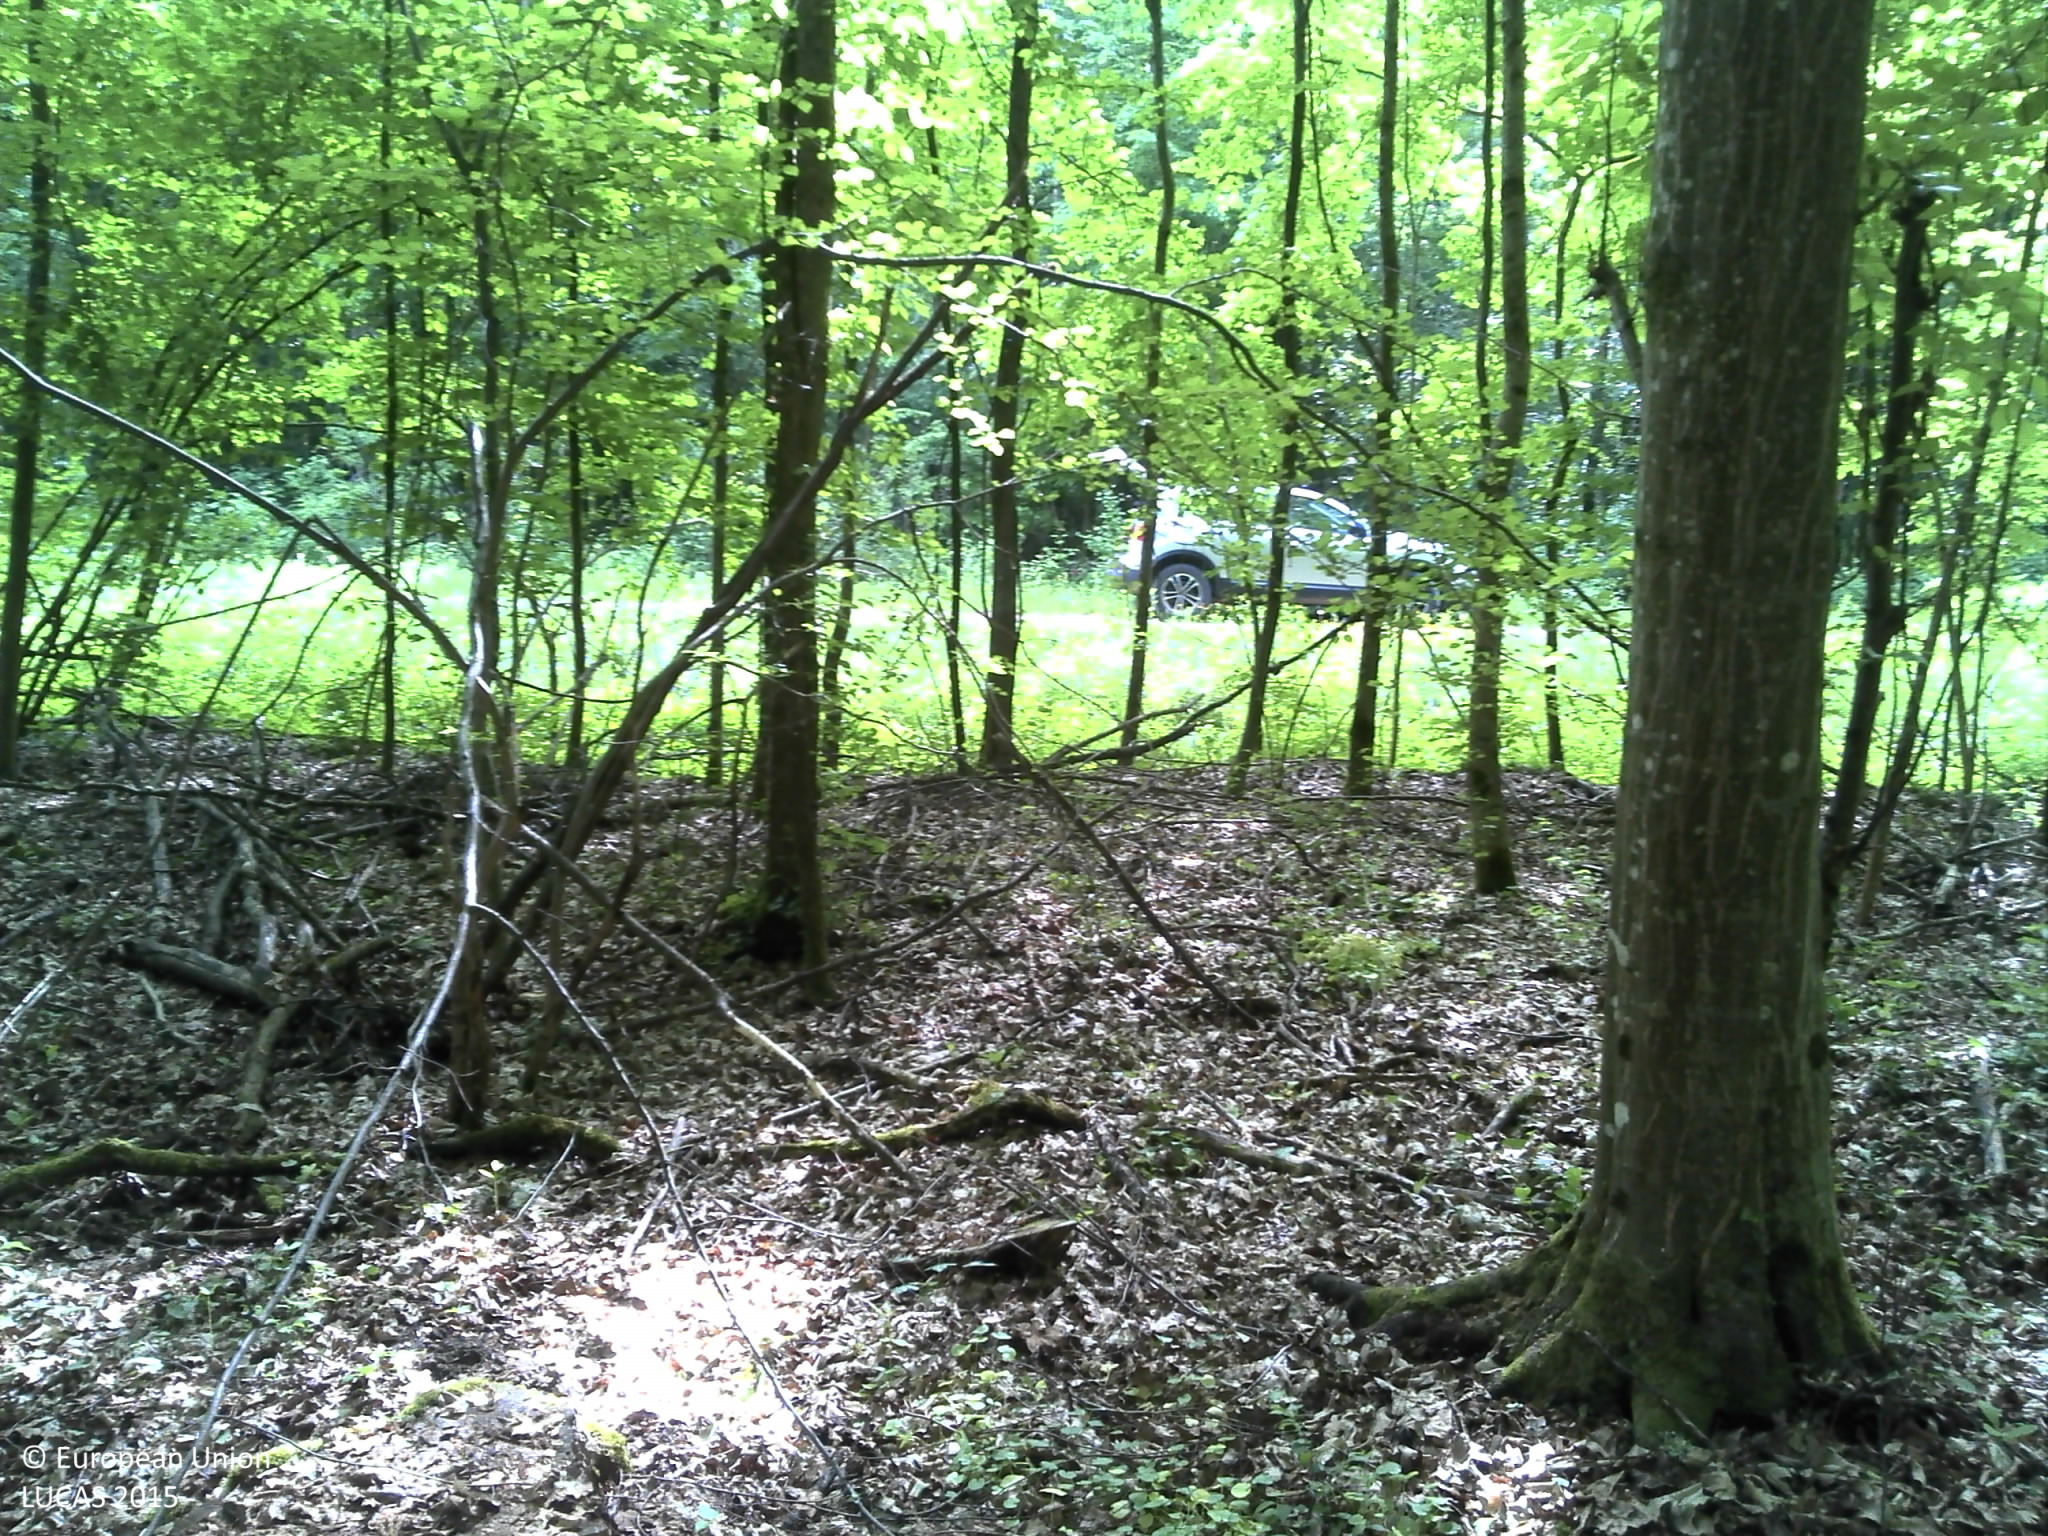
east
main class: Woodland
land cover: Broadleaved woodland
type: mesophytic deciduous forest
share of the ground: > 75 %
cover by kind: broadleaved forest trees 100 %
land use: Forestry
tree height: > 5 m
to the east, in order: Broadleaved woodland; Ditches and canals; Tracks; Ditches and canals; Broadleaved woodland; Fences; Broadleaved woodland
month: May
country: HR
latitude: 45.1516
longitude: 18.6166
